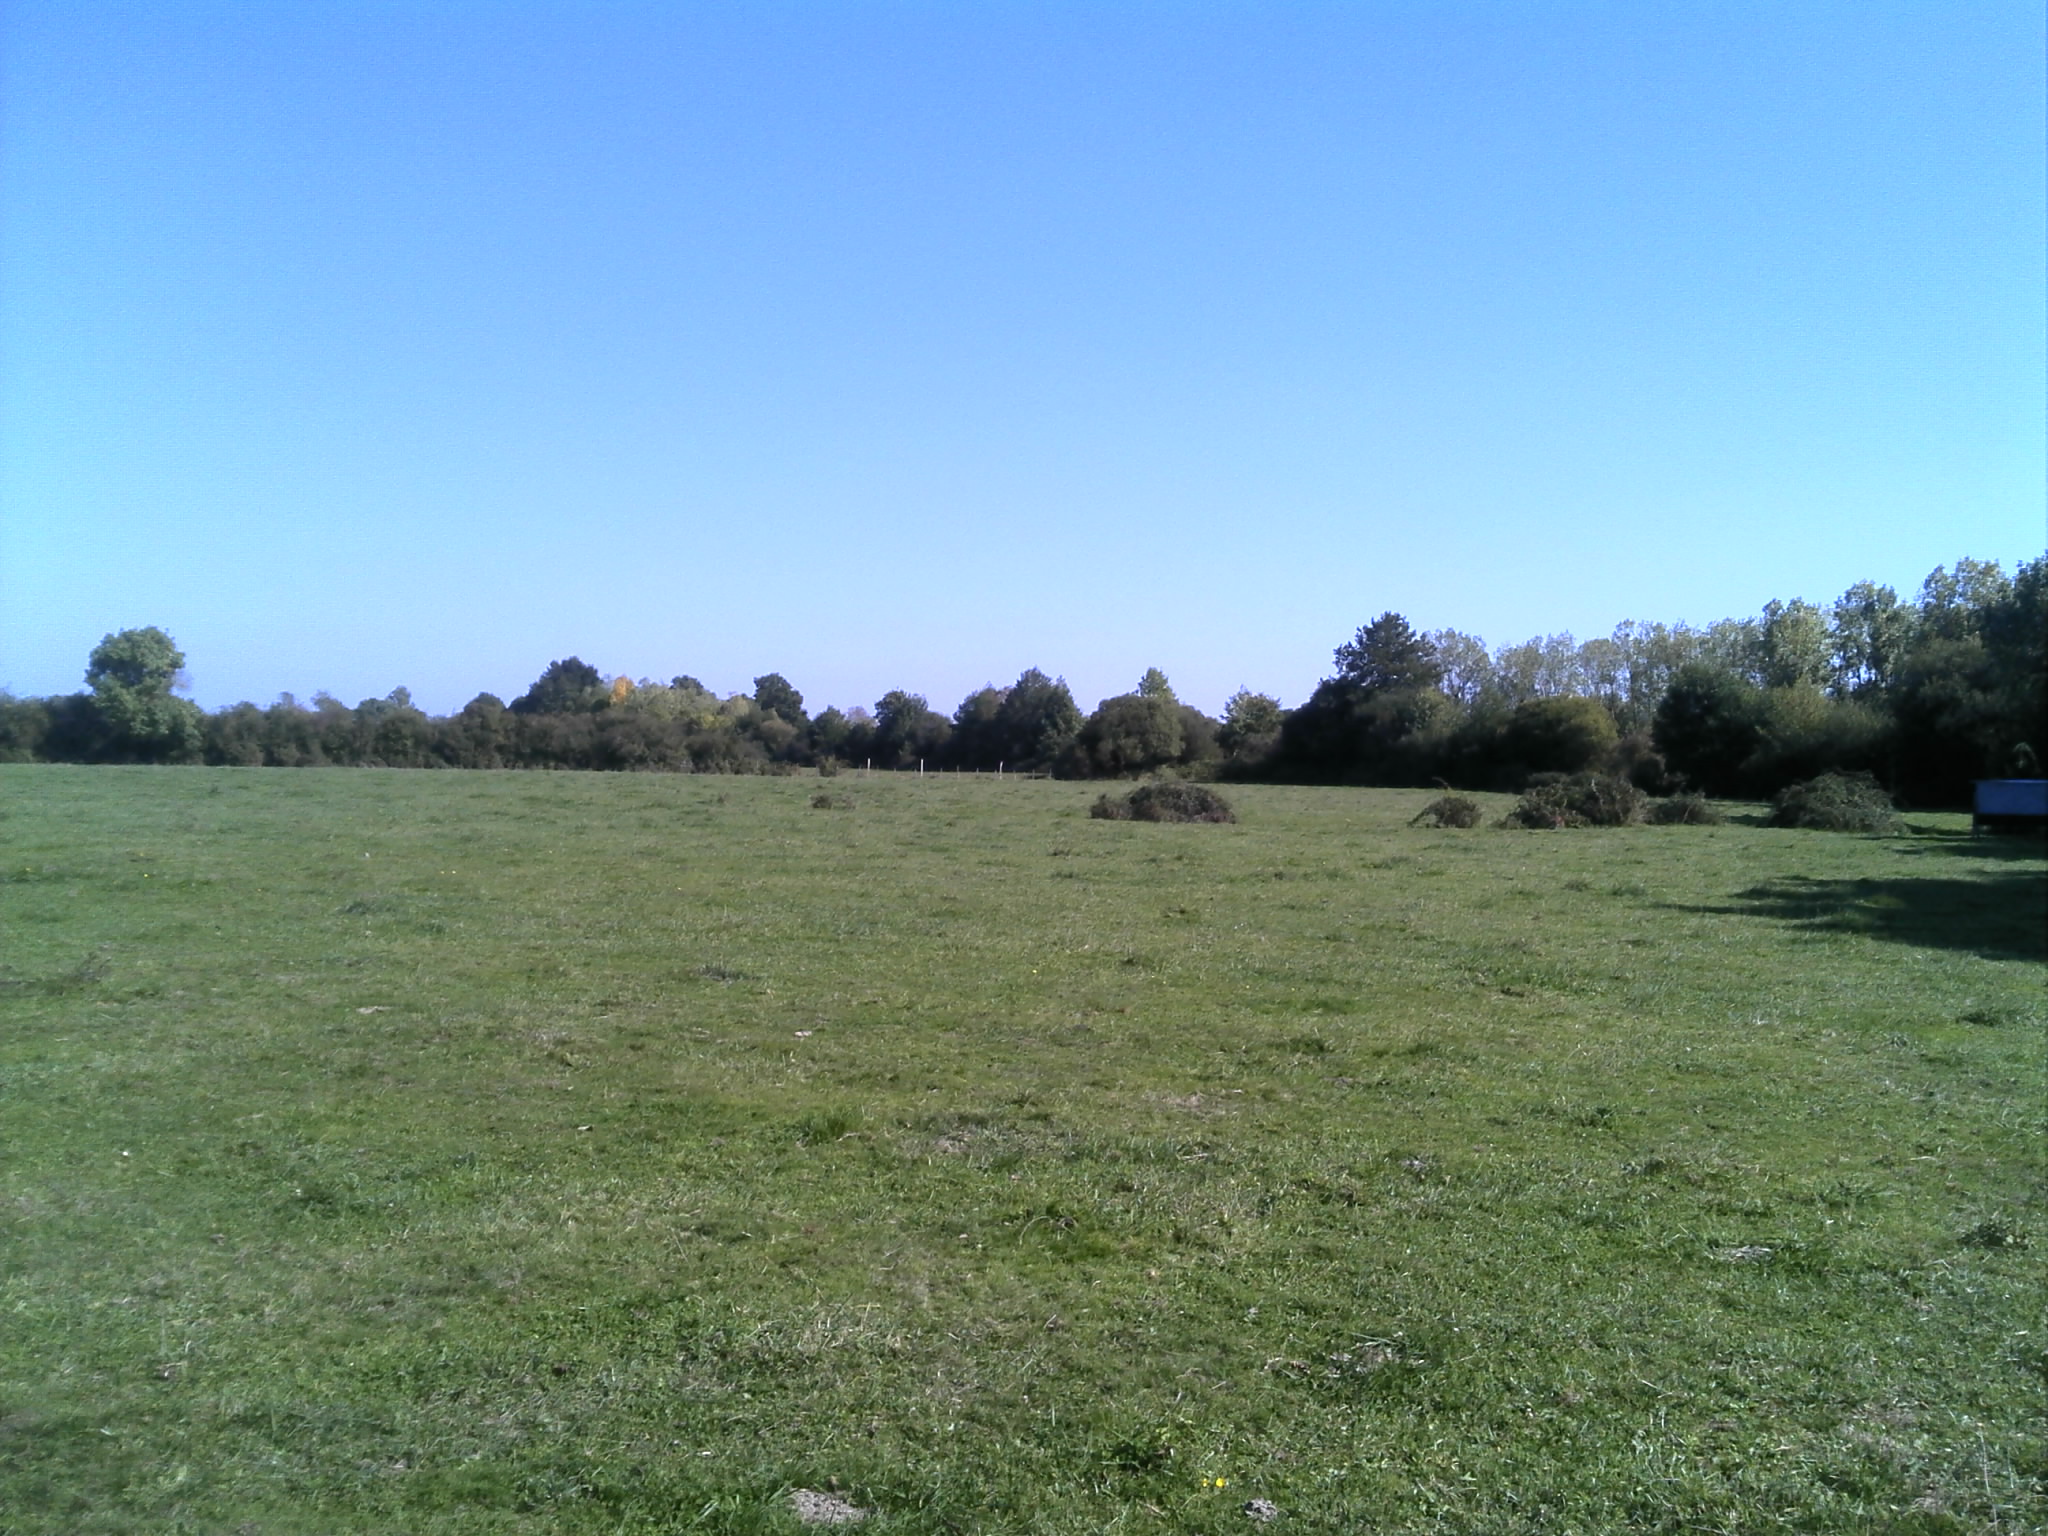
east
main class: Grassland
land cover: Grassland without tree/shrub cover
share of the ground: > 75 %
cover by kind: herbaceous plants 100 %
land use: Agriculture (excluding fallow land and kitchen gardens)
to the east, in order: Grassland without tree/shrub cover; Fences; Managed hedges; Ditches and canals; Temporary grasslands
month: October
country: FR
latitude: 47.5292
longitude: -0.9679
